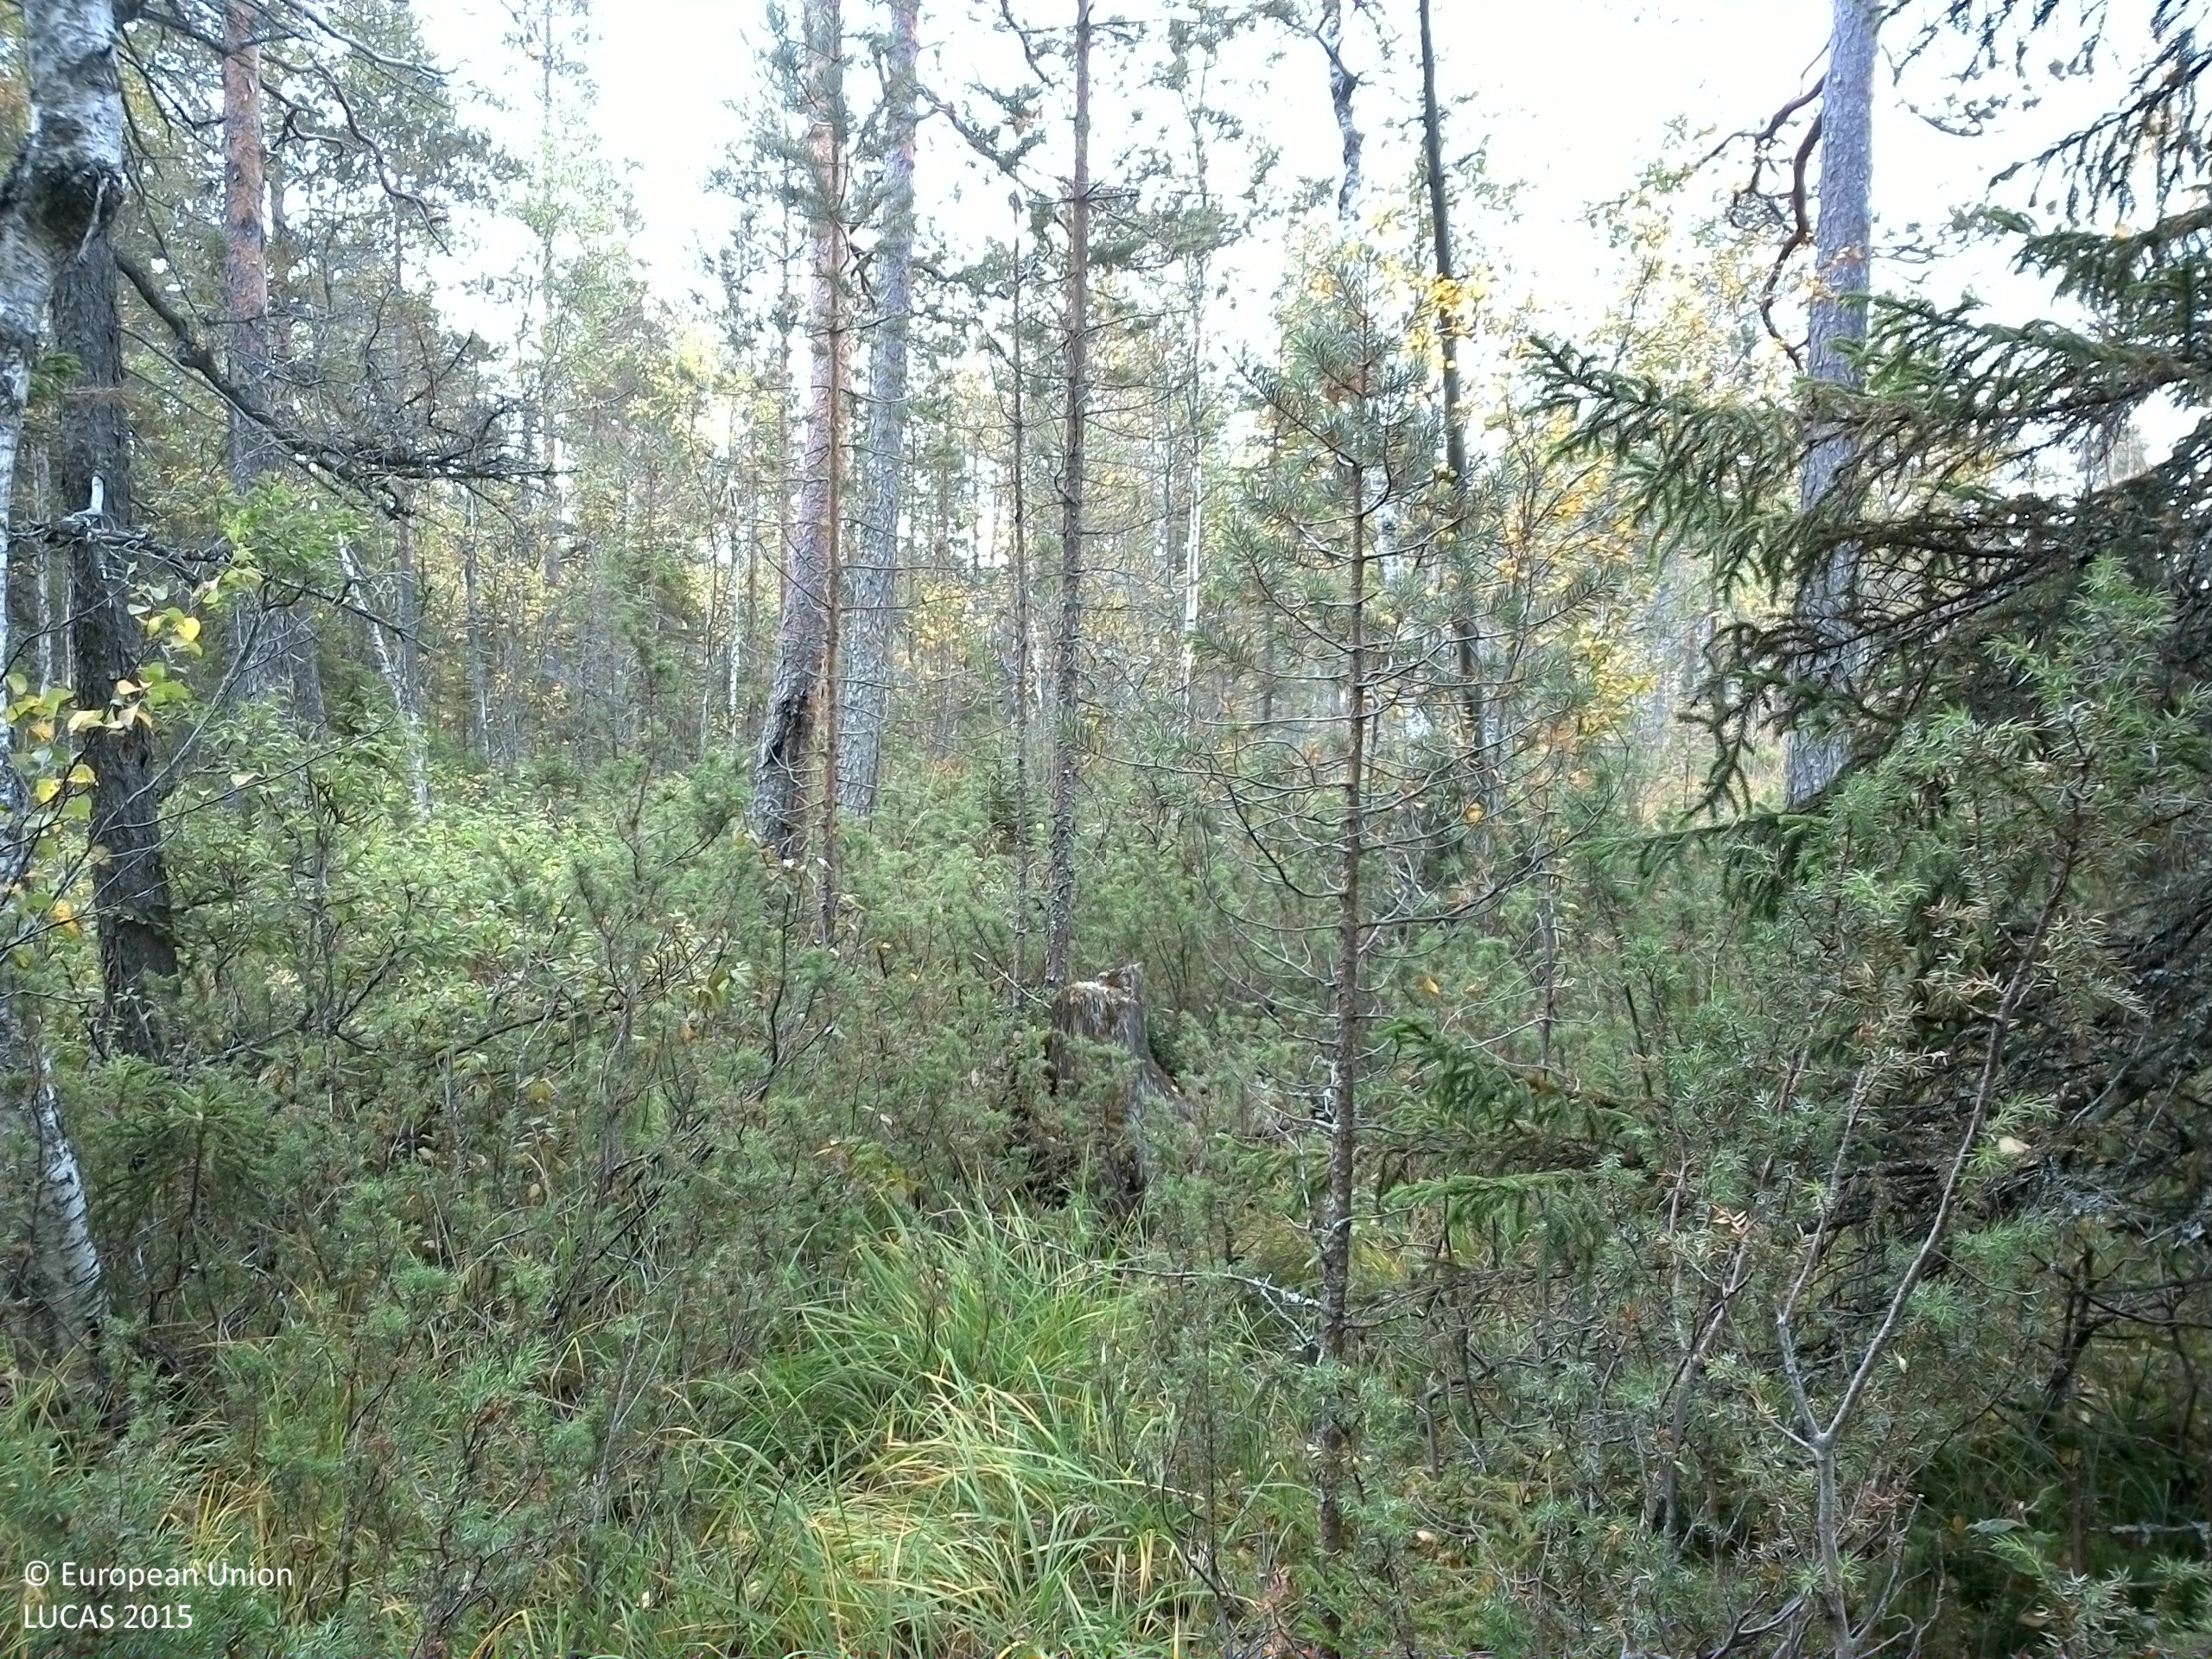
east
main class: Woodland
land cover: Pine dominated mixed woodland
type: boreal forest
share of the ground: 50 - 75 %
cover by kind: coniferous forest trees 45 %, broadleaved forest trees 20 %, lichens and mosses 20 %, shrubs 15 %
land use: Forestry
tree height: > 5 m
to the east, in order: Pine dominated mixed woodland; Rivers and streams; Pine dominated mixed woodland; Spruce dominated mixed woodland; Spruce dominated coniferous woodland; Shrubland with sparse tree cover
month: September
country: SE
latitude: 61.5485
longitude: 15.1584
